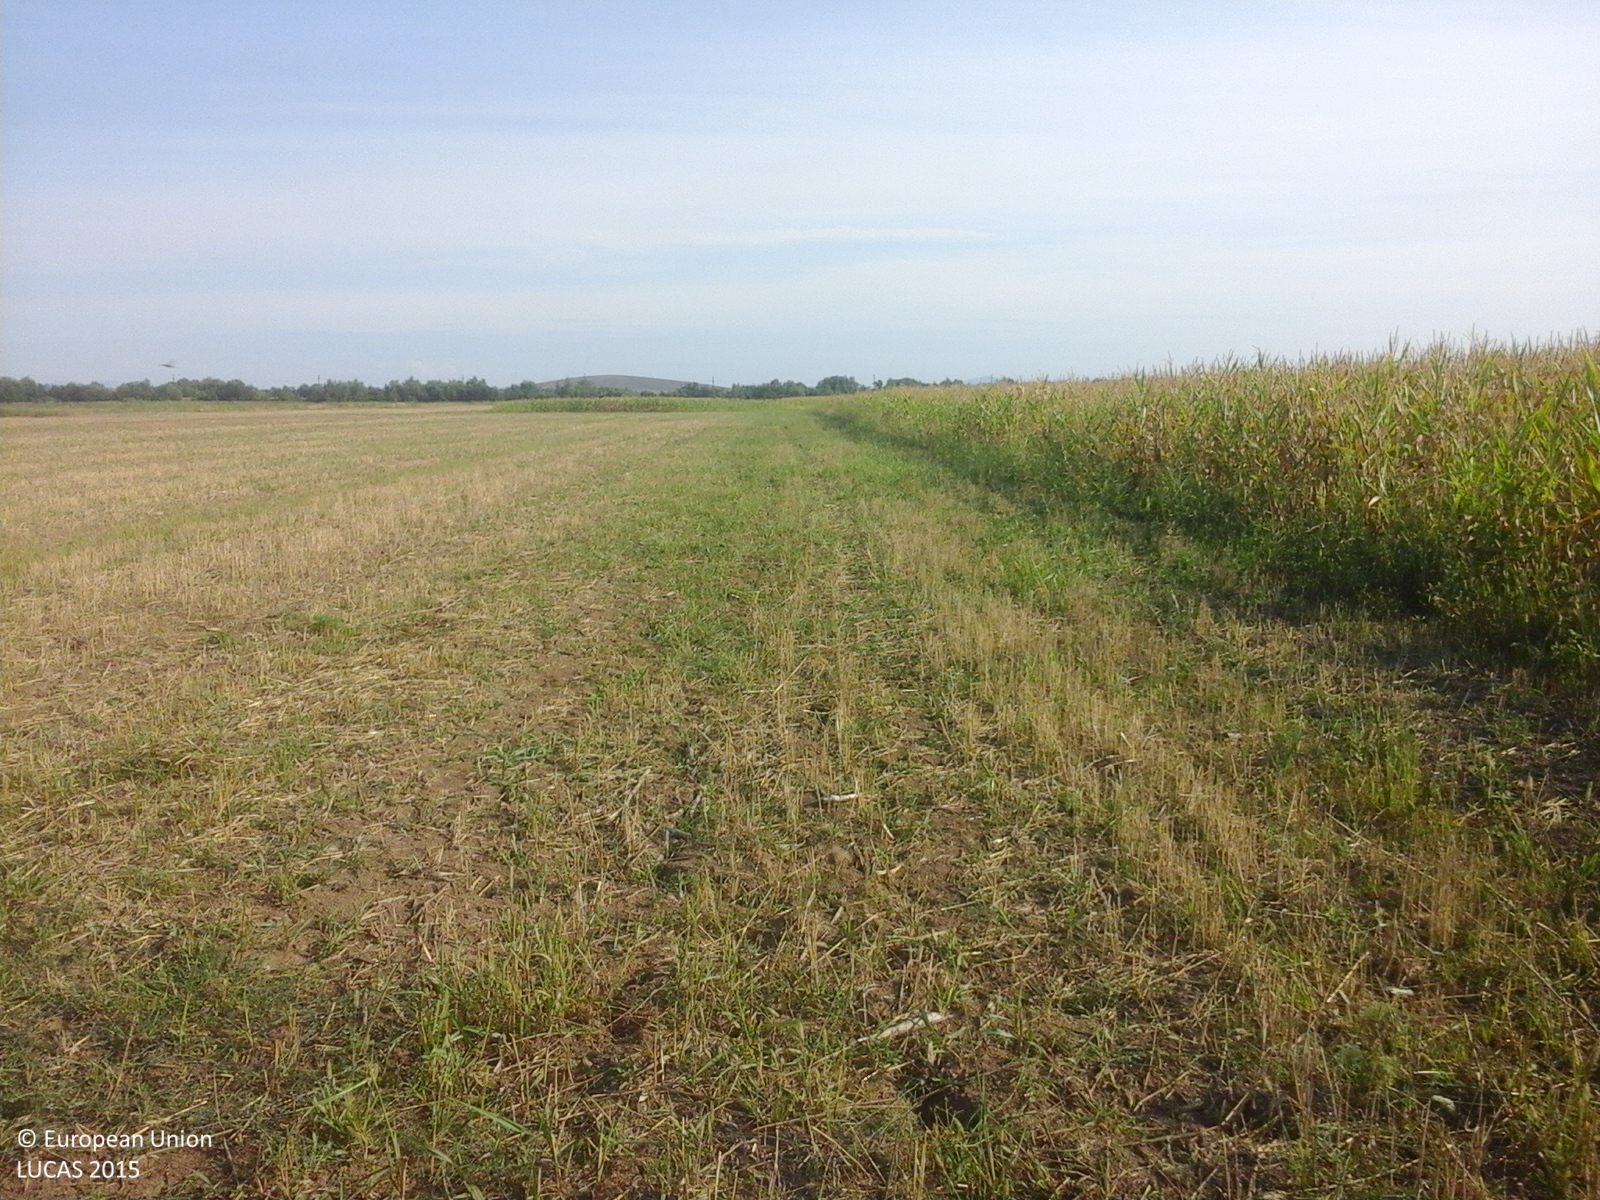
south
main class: Cropland
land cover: Maize
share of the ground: > 75 %
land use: Agriculture (excluding fallow land and kitchen gardens)
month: August
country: RO
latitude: 45.4311
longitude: 21.3939
